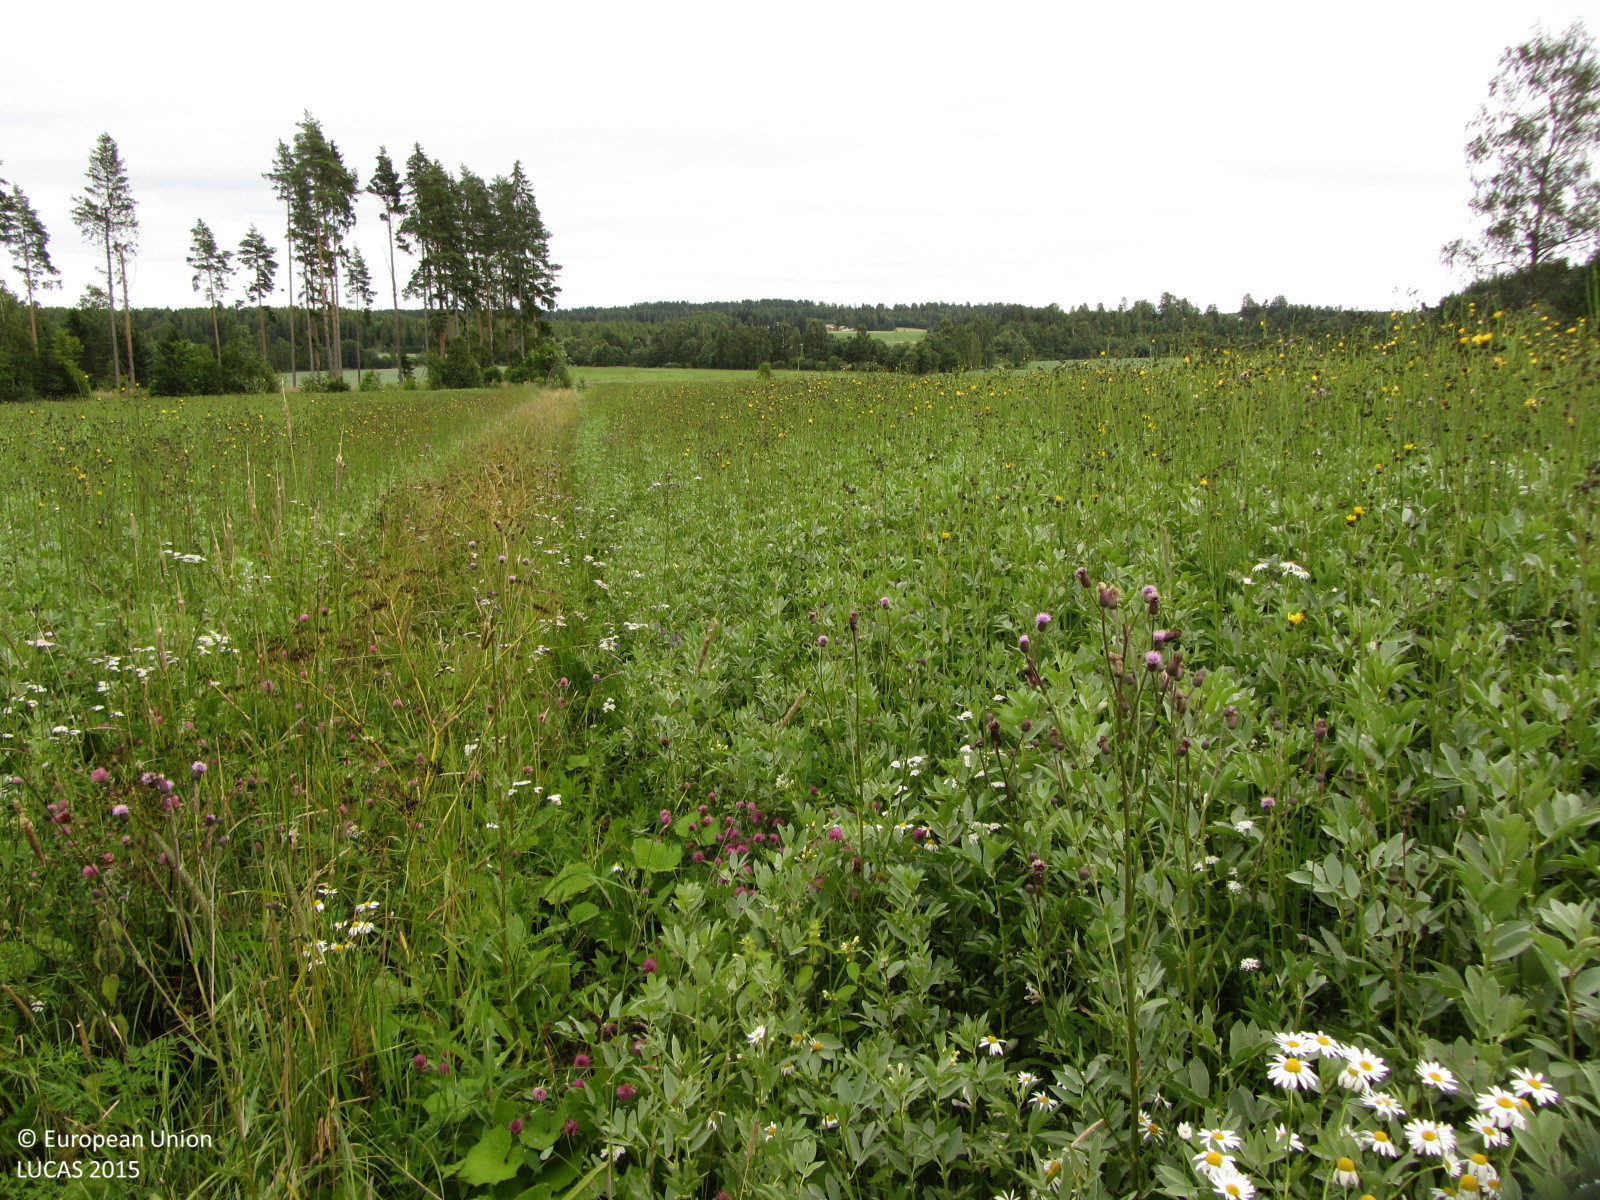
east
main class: Cropland
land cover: Dry pulses
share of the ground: > 75 %
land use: Agriculture (excluding fallow land and kitchen gardens)
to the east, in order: Dry pulses; Ditches and canals; Dry pulses; Ditches and canals; Other mixed woodland; Spontaneously vegetated surfaces; Common wheat; Spontaneously vegetated surfaces; Paved roads, cycling and walking lanes; Spontaneously vegetated surfaces; Ditches and canals; Spontaneously vegetated surfaces
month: July
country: FI
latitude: 60.4838
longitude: 24.2025
